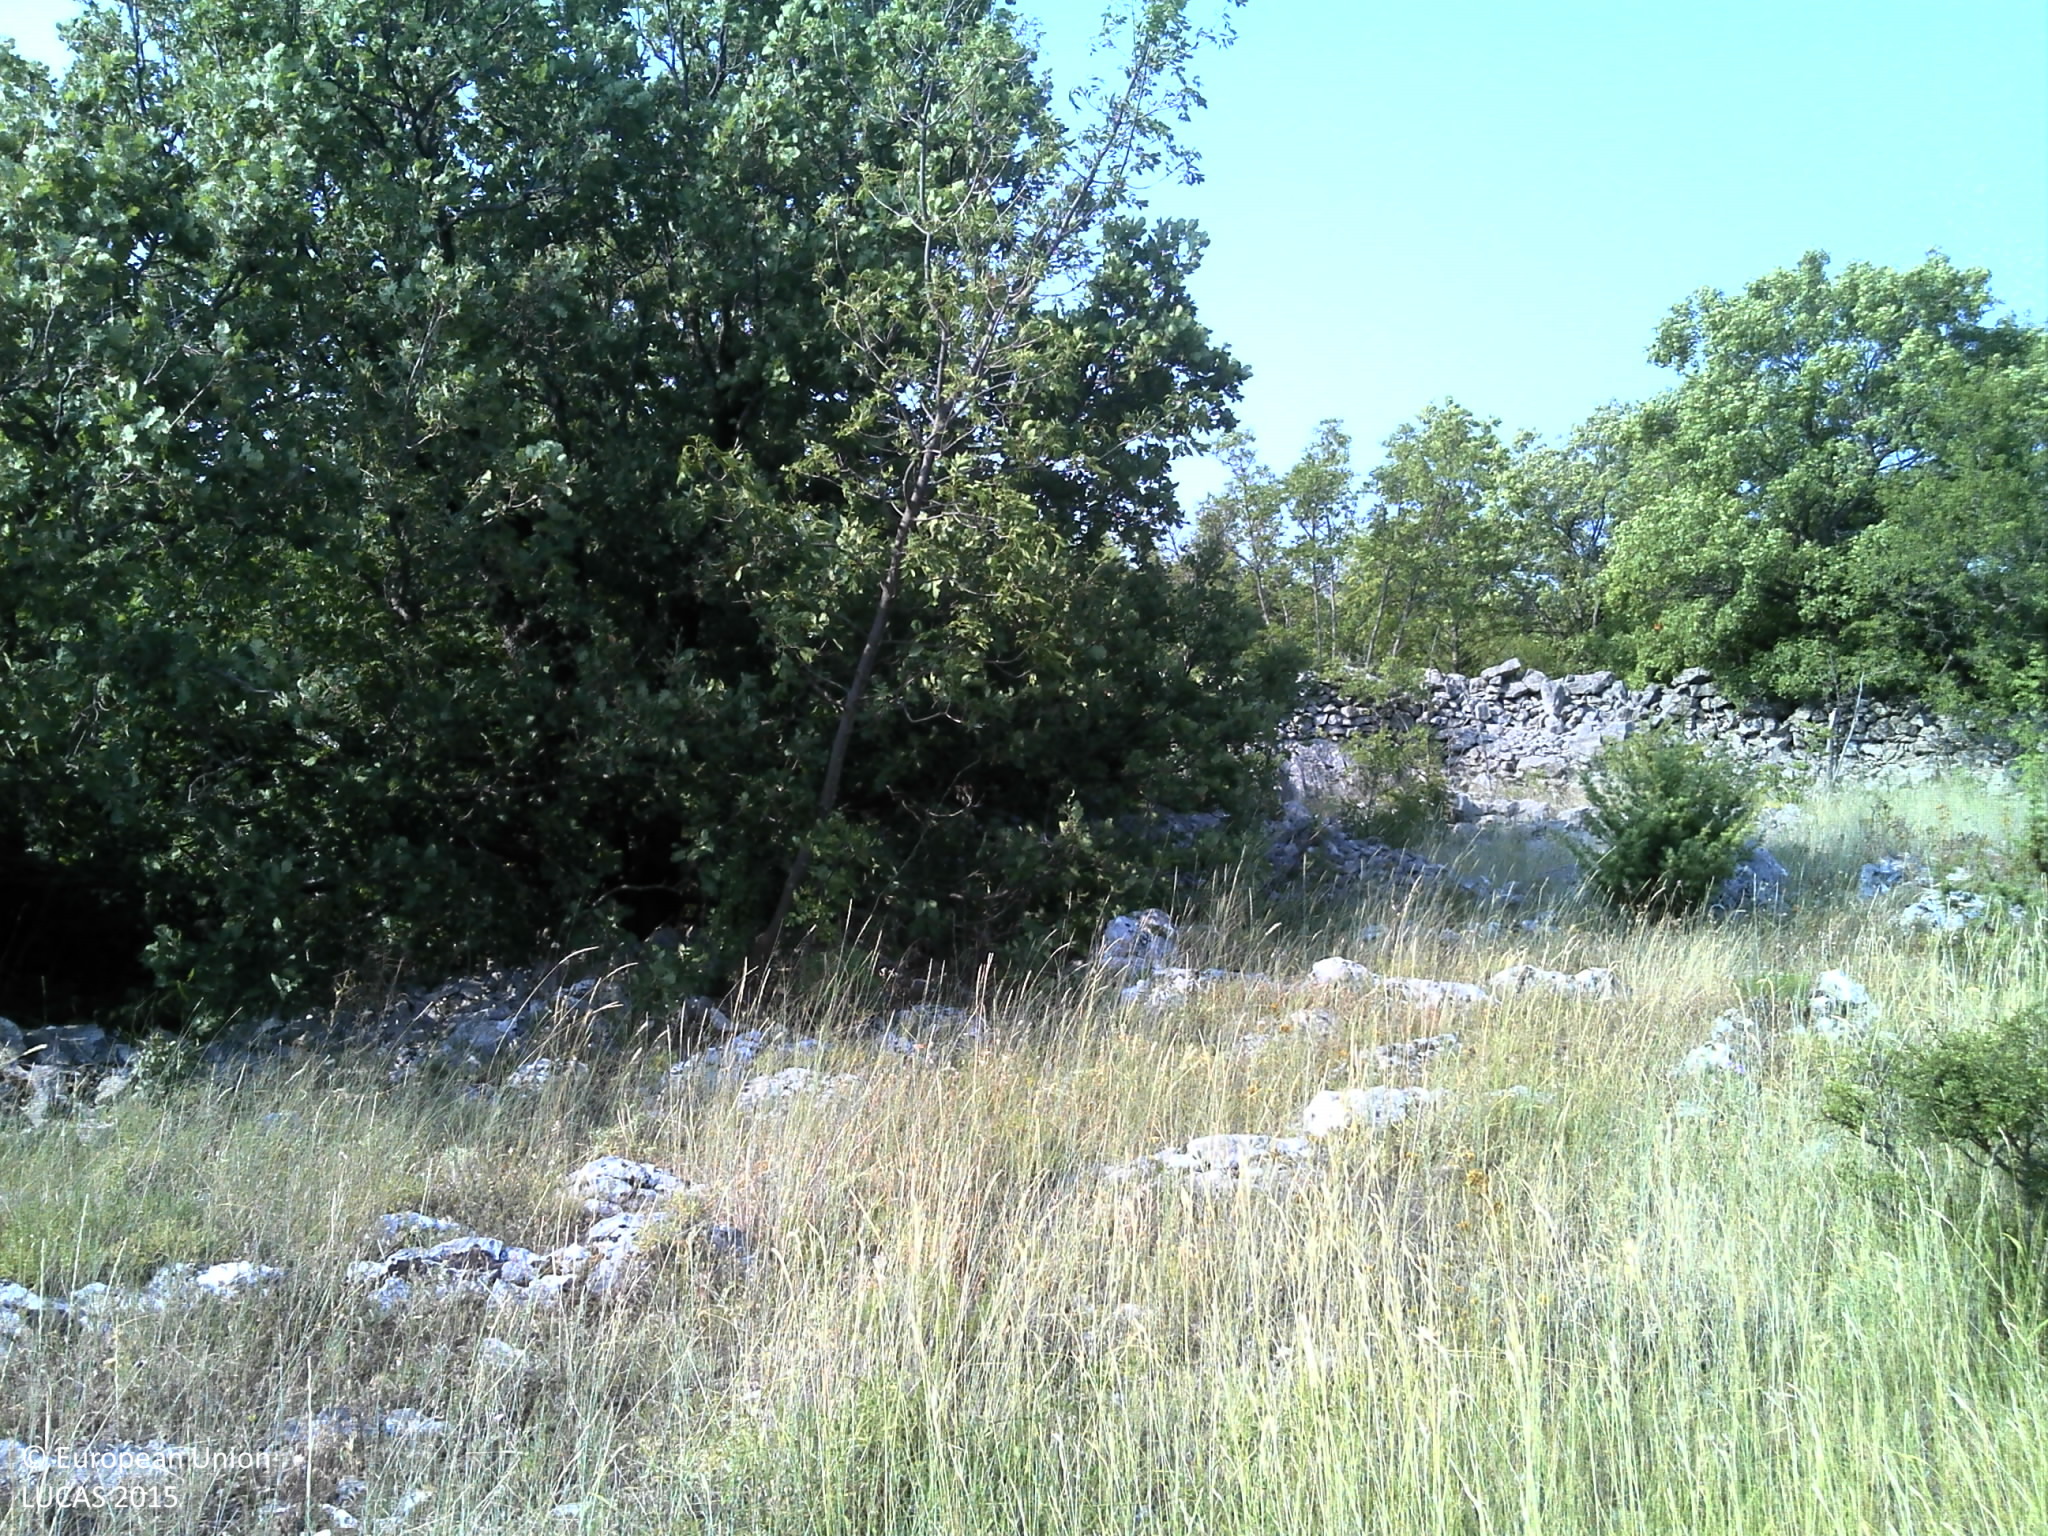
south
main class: Grassland
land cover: Grassland with sparse tree/shrub cover
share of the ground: > 75 %
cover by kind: herbaceous plants 70 %, shrubs 10 %, broadleaved forest trees 5 %, lichens and mosses 5 %, consolidated bare surface 5 %, unconsolidated bare surface 5 %
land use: Abandoned areas
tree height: > 5 m
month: July
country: HR
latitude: 43.4674
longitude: 16.9258
